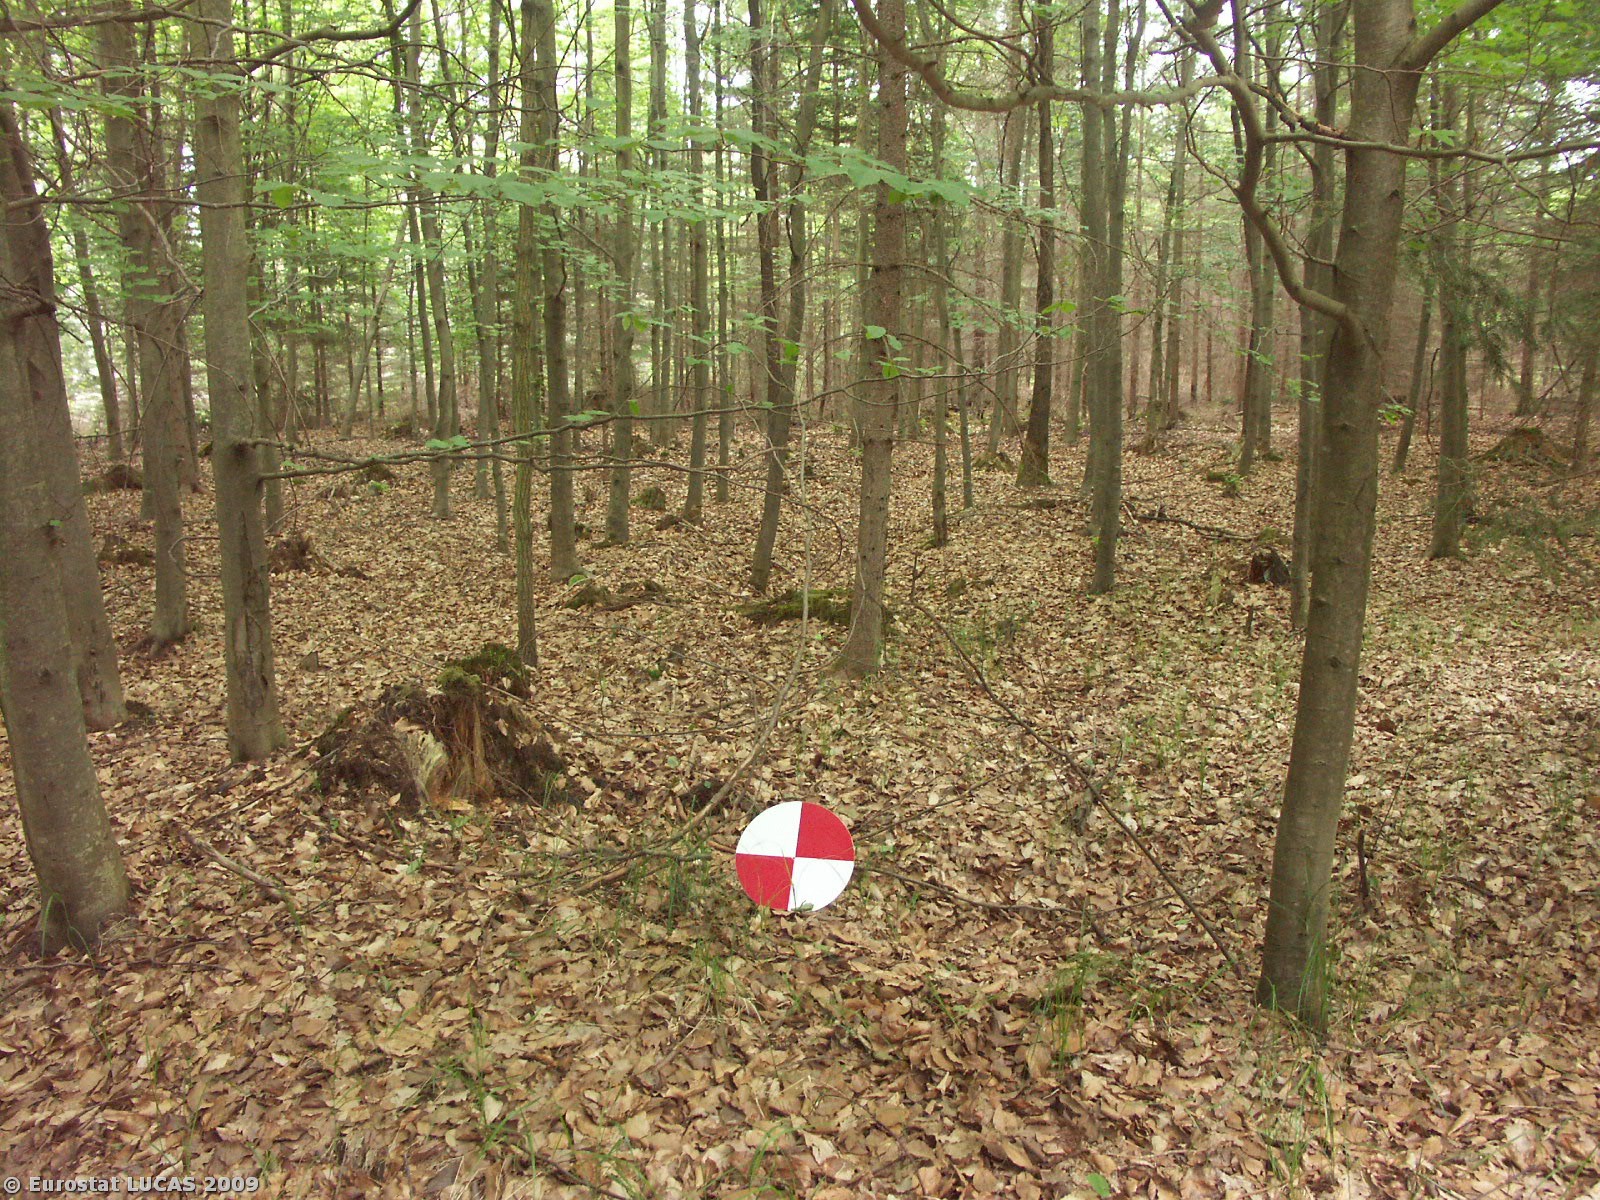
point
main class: Woodland
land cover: Broadleaved woodland
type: beech forest
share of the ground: > 75 %
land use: Forestry
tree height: > 5 m
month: May
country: CZ
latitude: 48.8227
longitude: 14.7823
